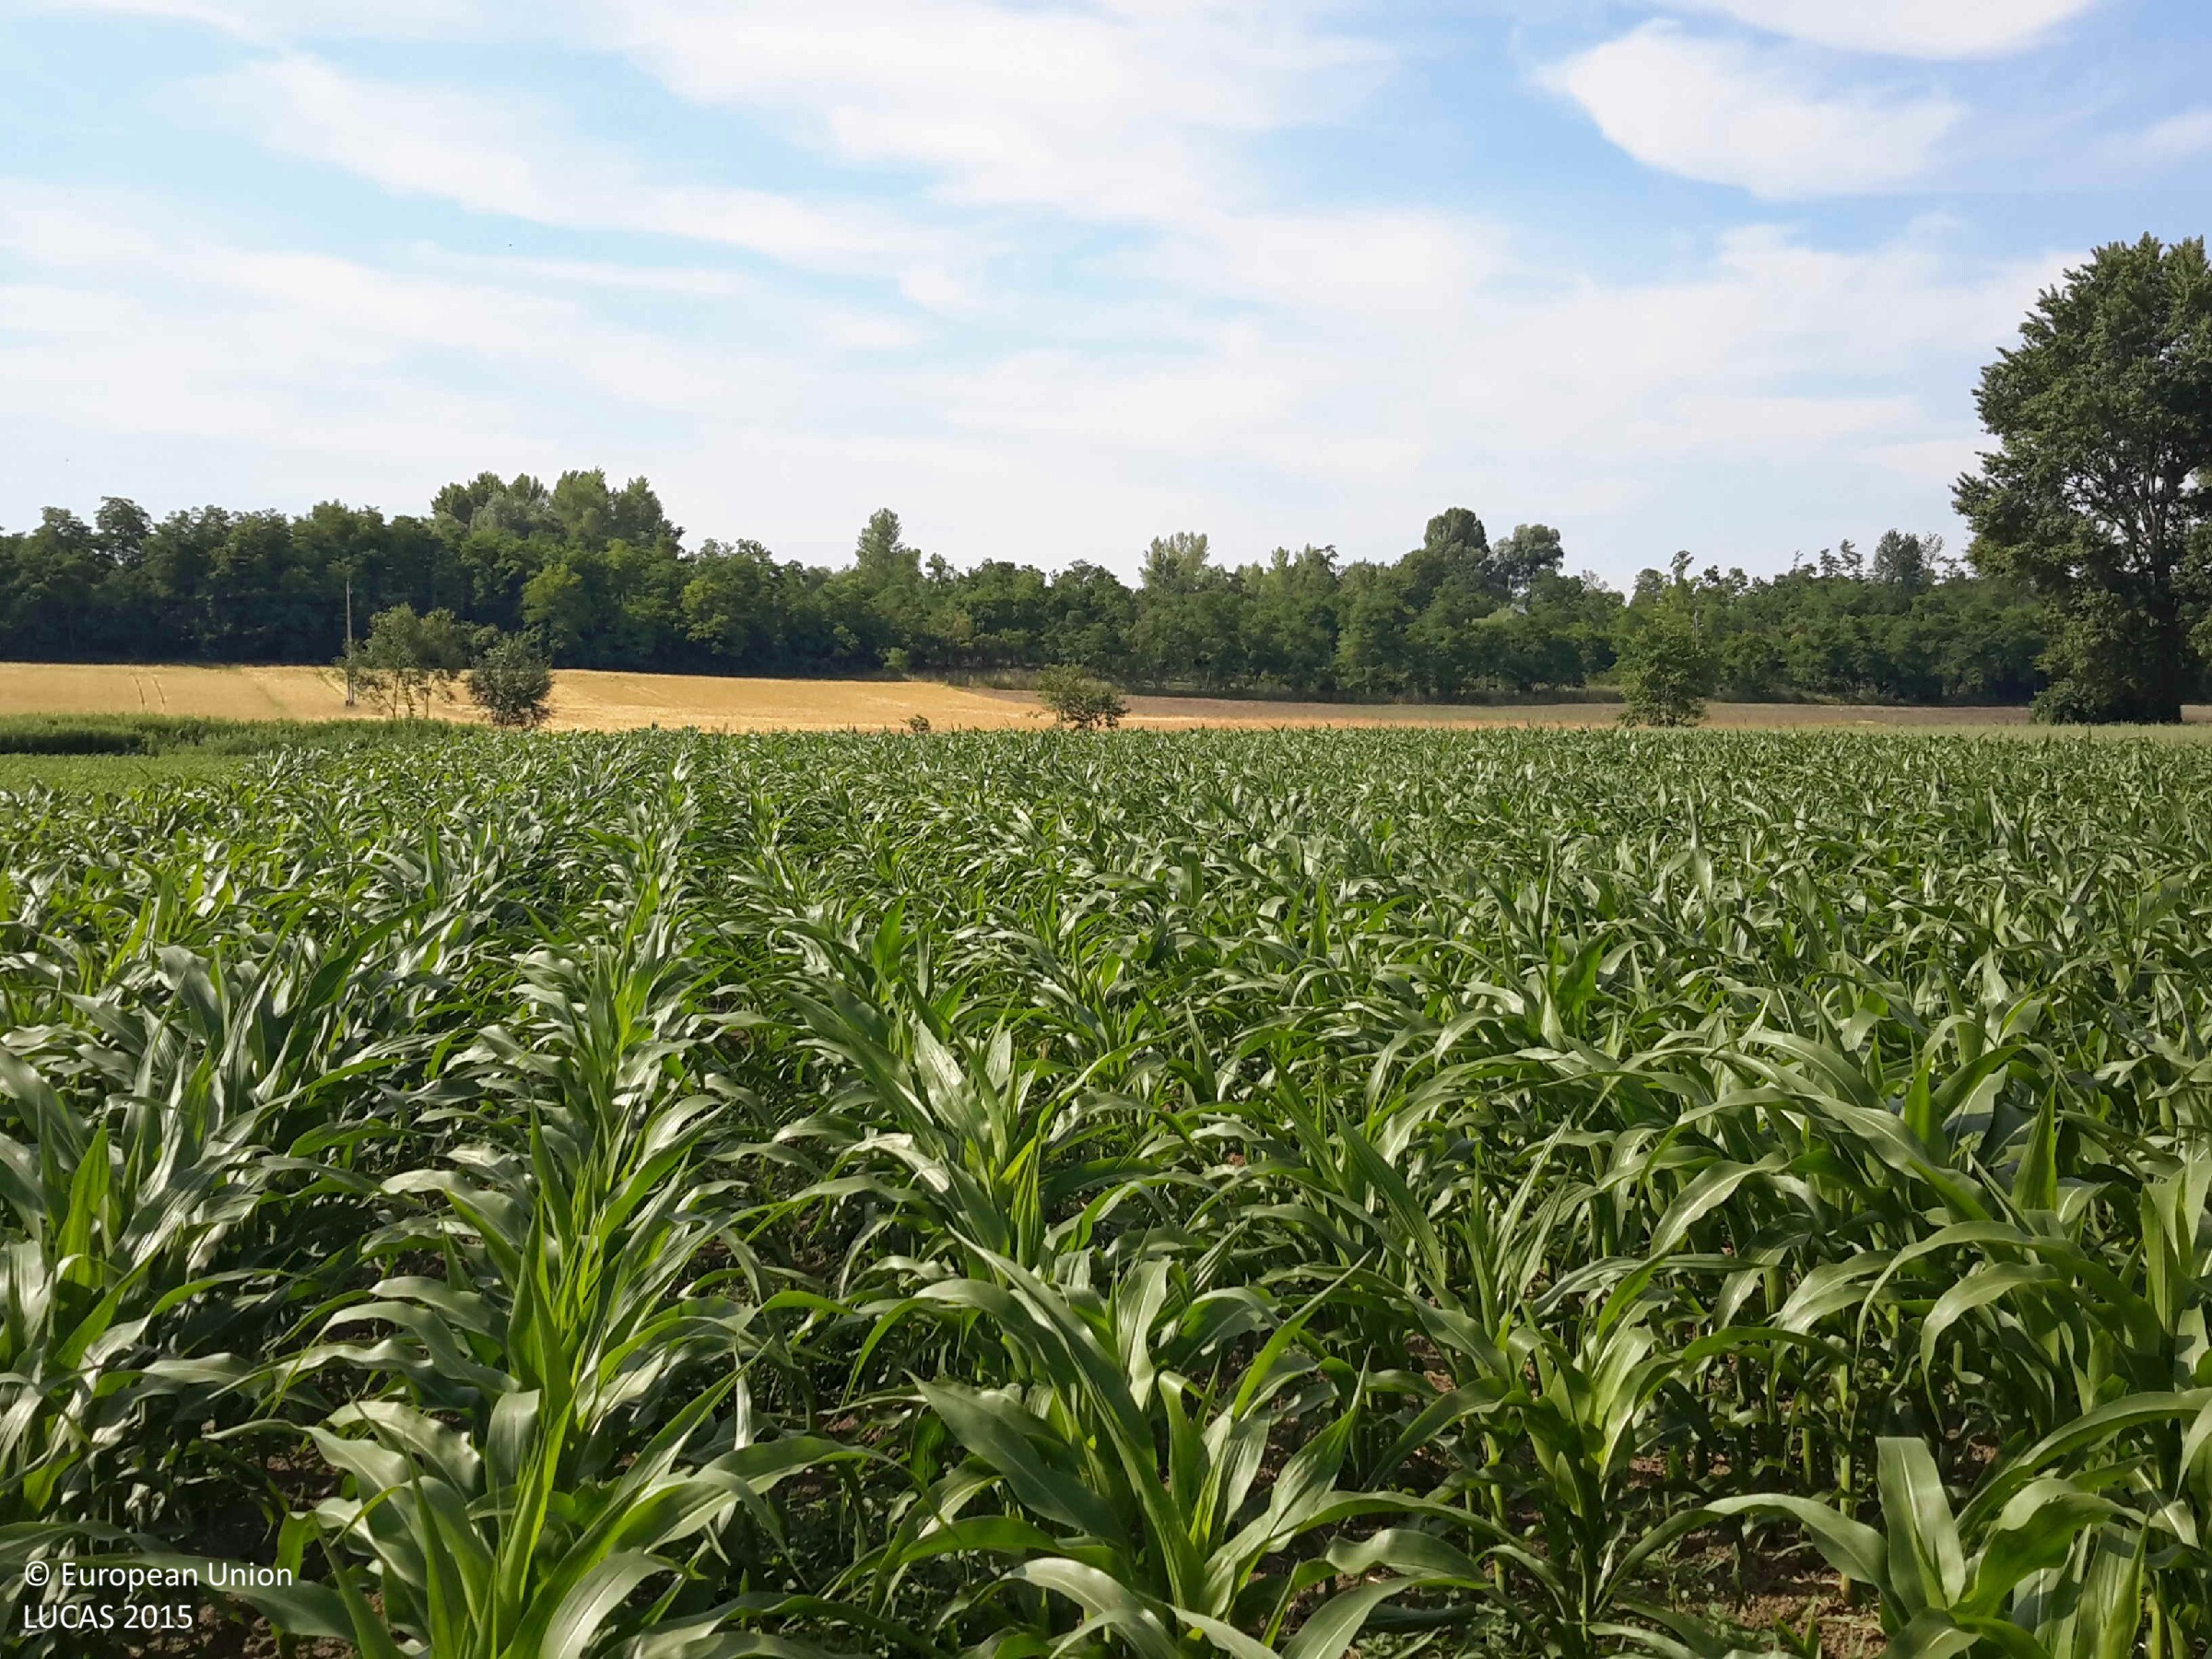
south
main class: Cropland
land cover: Maize
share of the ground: > 75 %
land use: Agriculture (excluding fallow land and kitchen gardens)
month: June
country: HU
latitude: 47.2469
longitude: 17.4719
